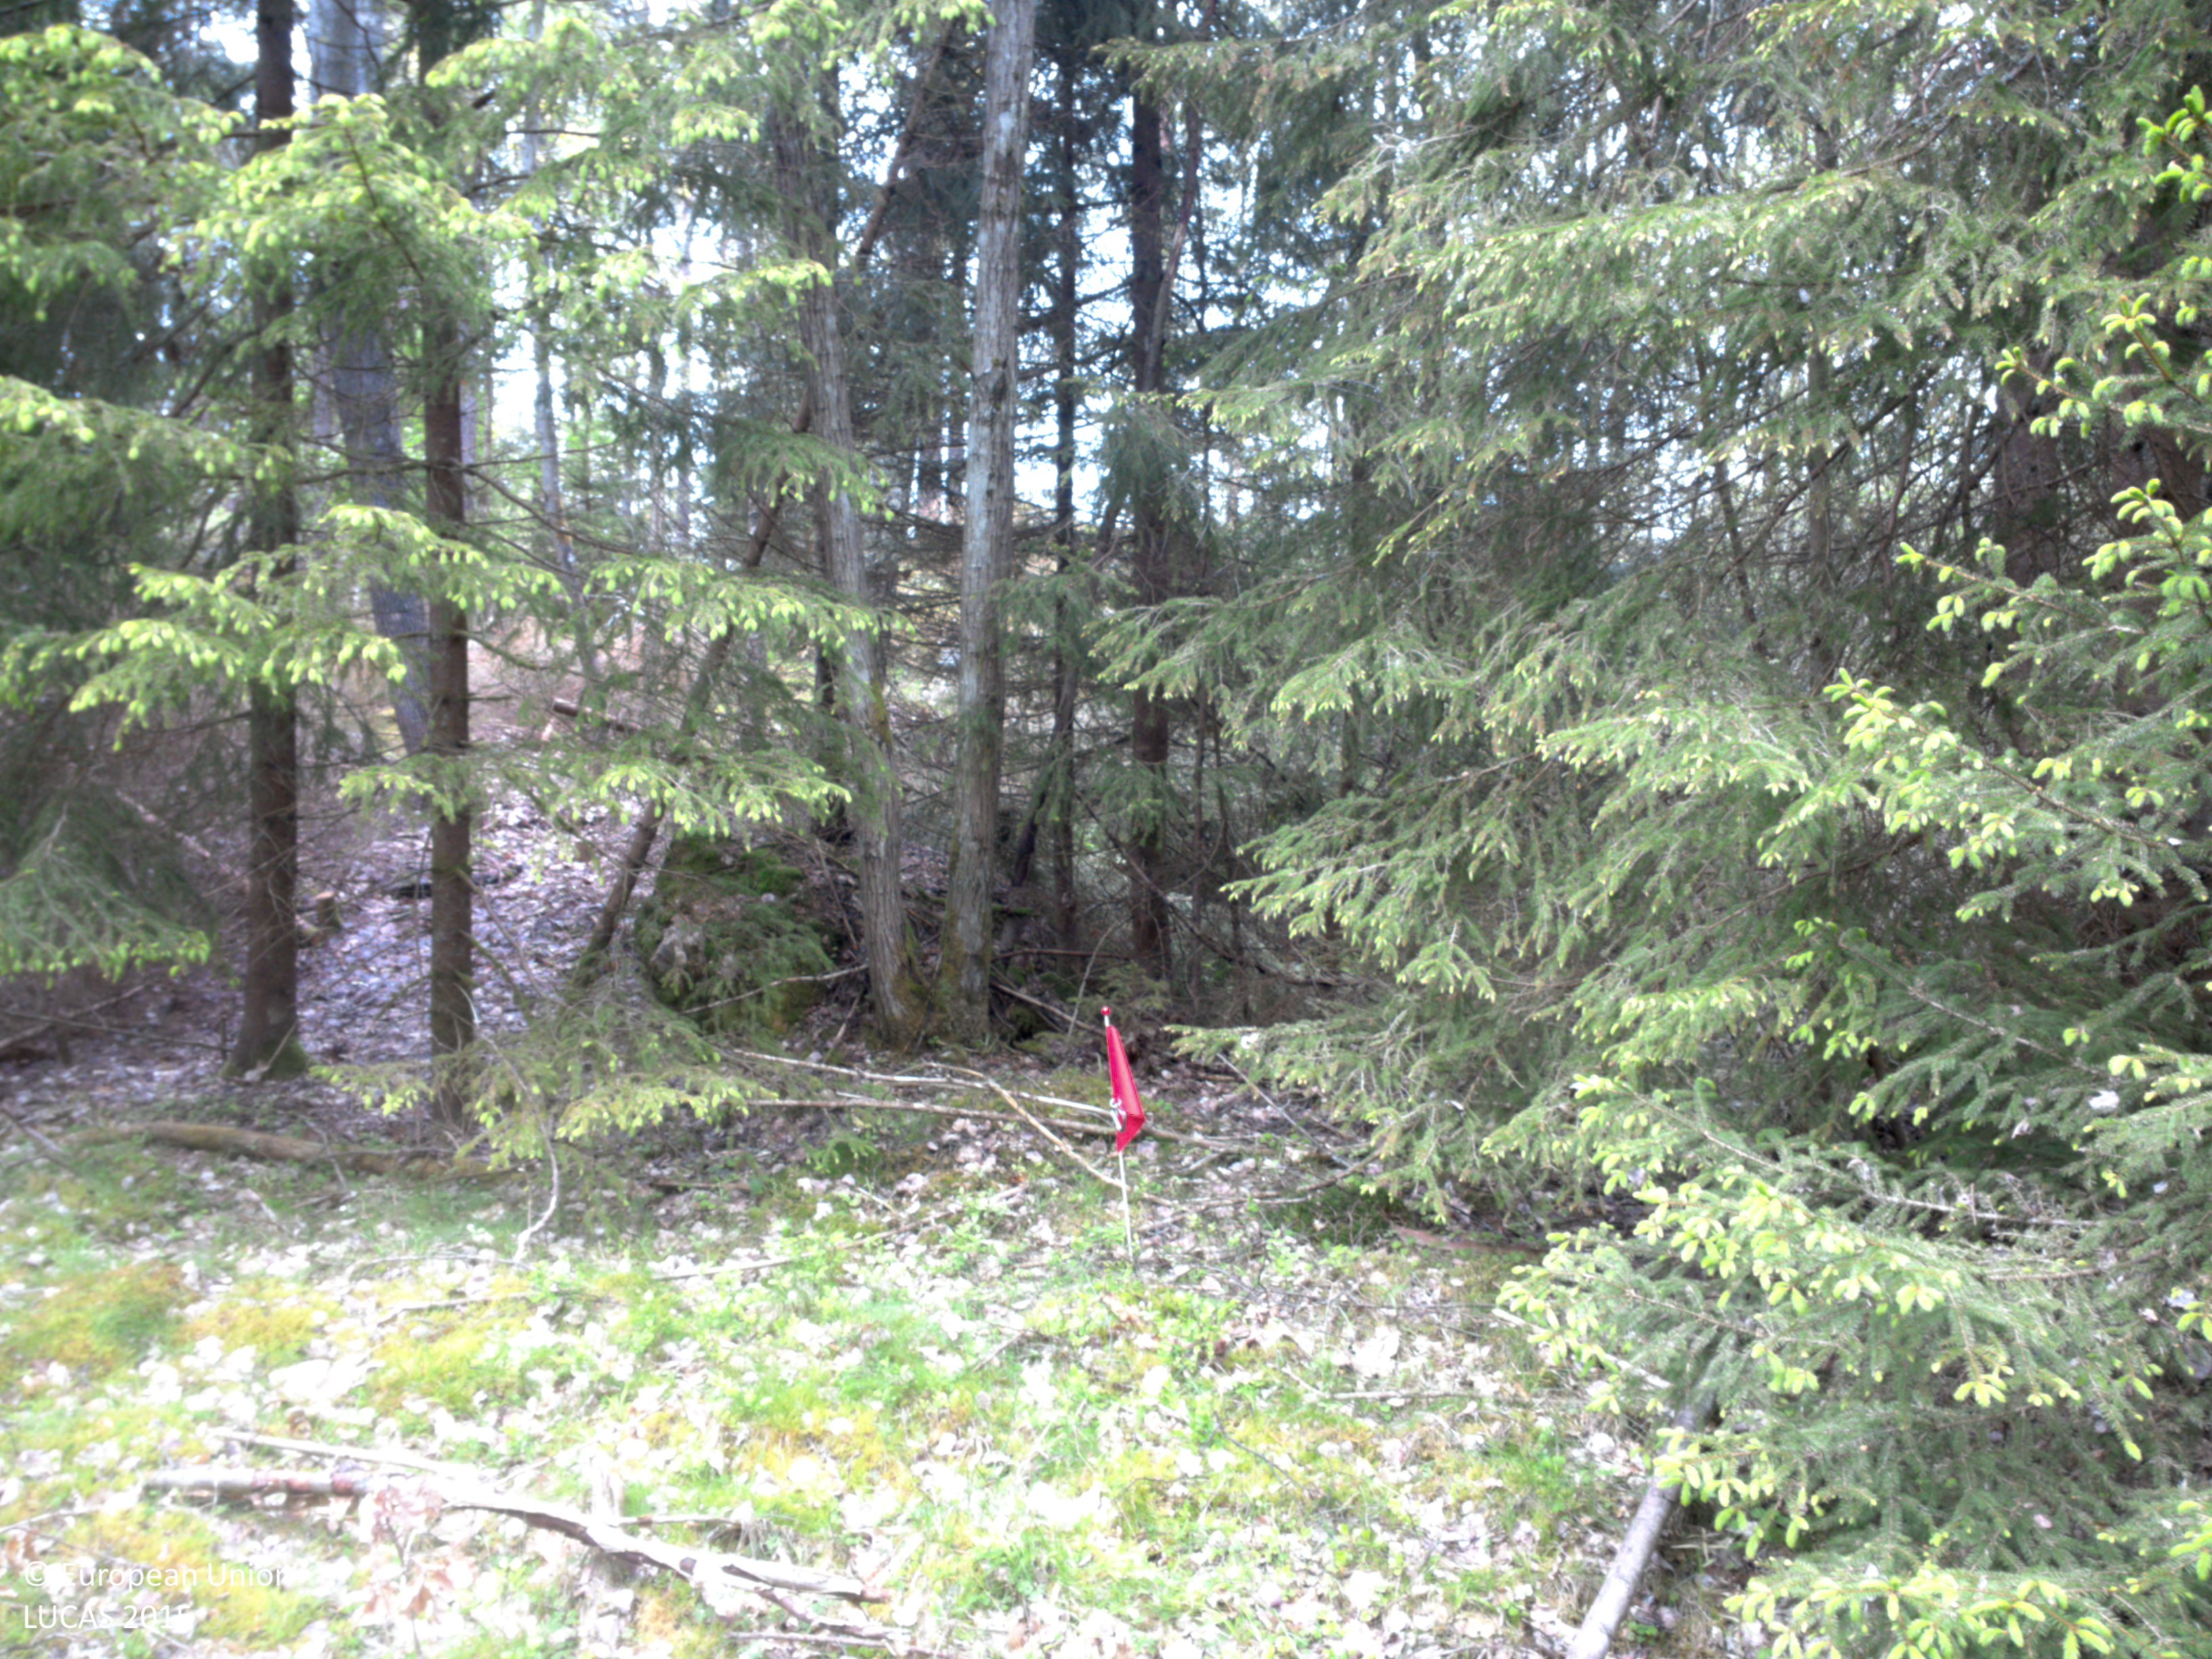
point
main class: Woodland
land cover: Spruce dominated mixed woodland
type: boreal forest
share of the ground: > 75 %
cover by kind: coniferous forest trees 55 %, broadleaved forest trees 25 %, herbaceous plants 20 %
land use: Forestry
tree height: > 5 m
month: May
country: SE
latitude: 58.2102
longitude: 11.5797
